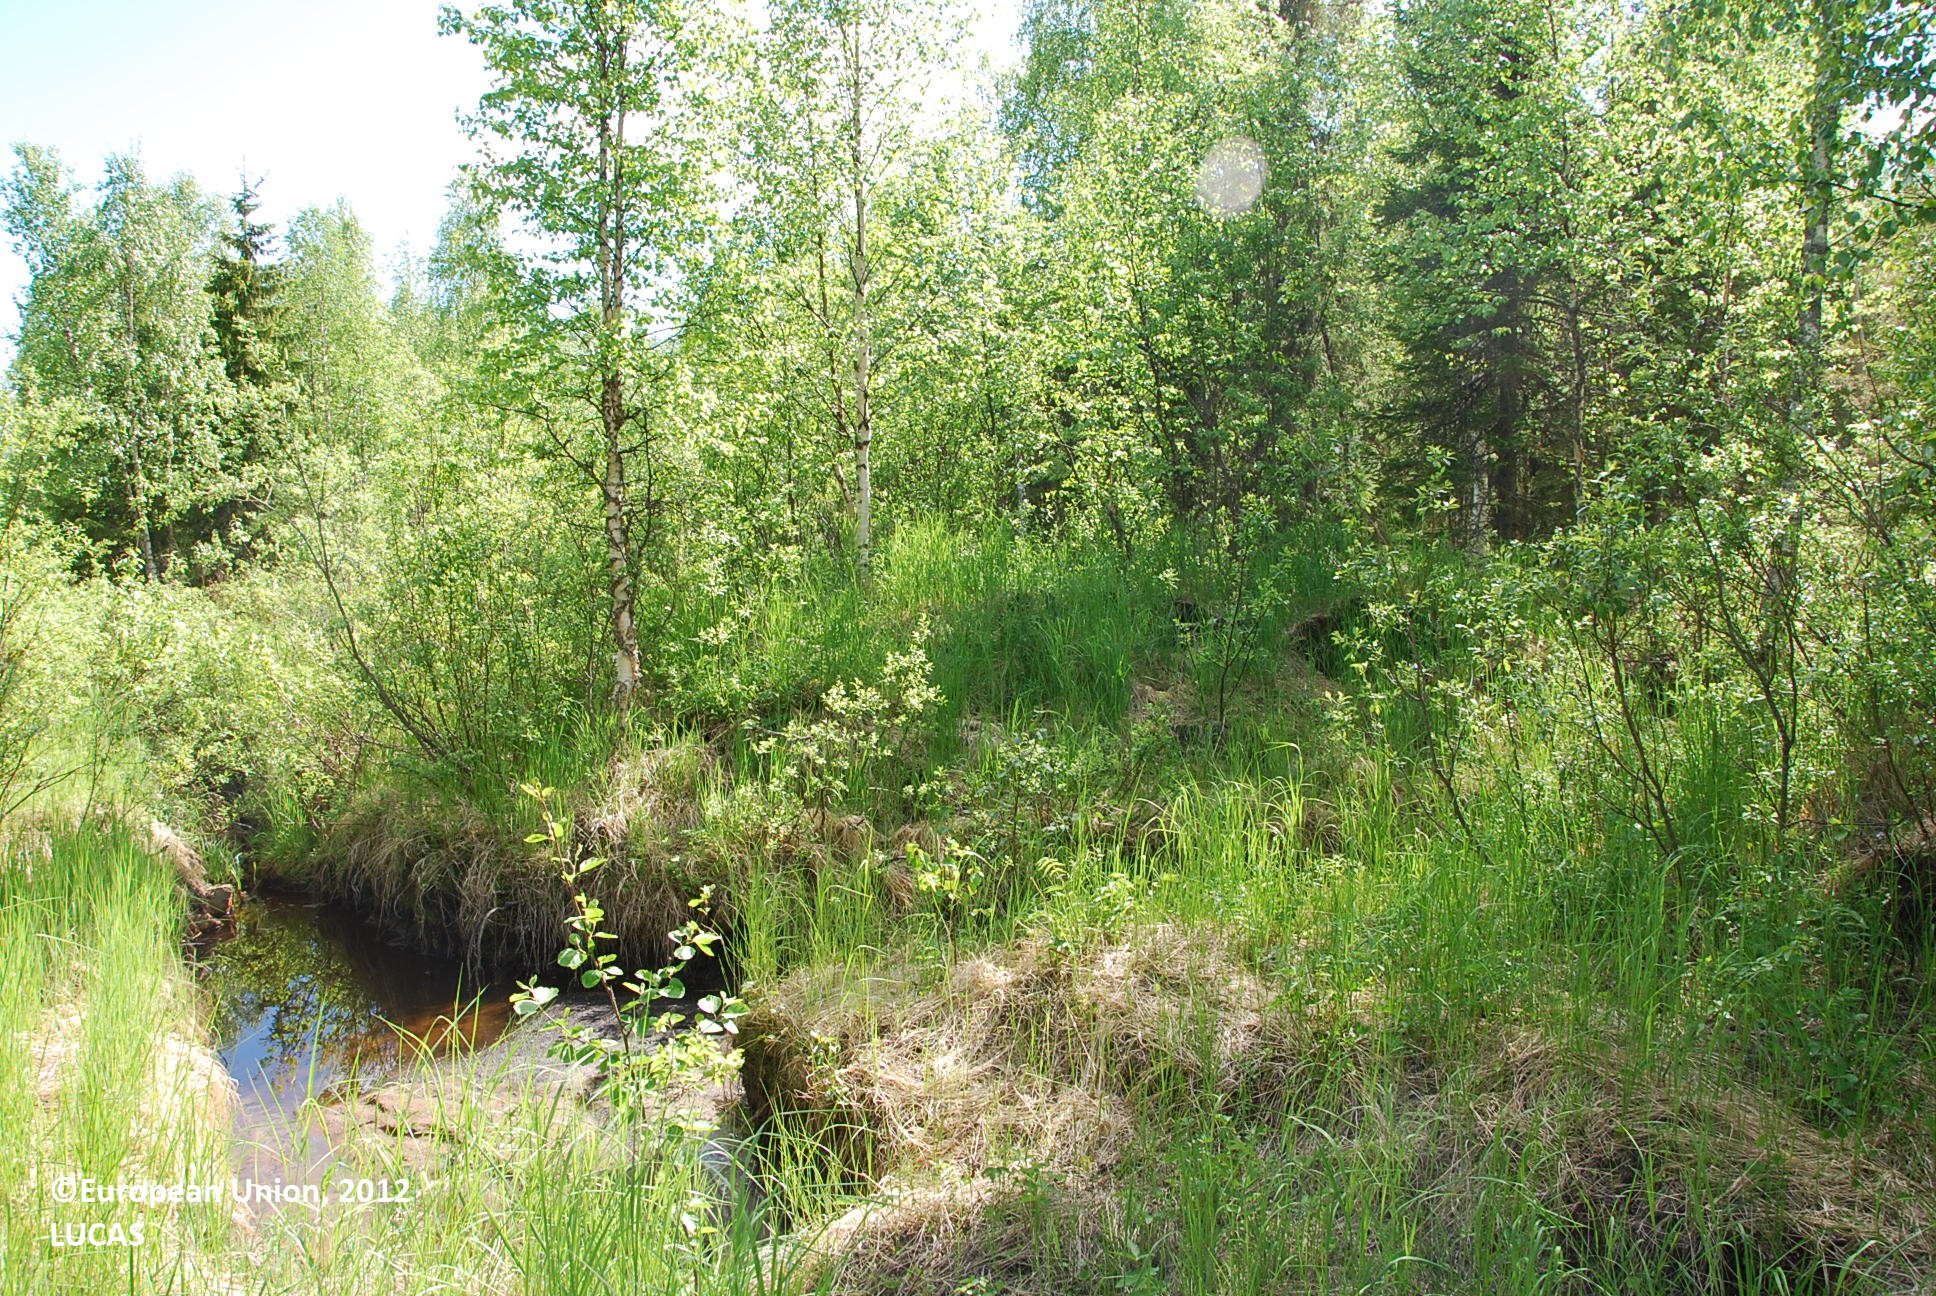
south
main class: Woodland
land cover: Broadleaved woodland
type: boreal forest
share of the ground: > 75 %
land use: Forestry
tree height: > 5 m
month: June
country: FI
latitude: 66.3735
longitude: 27.1679
